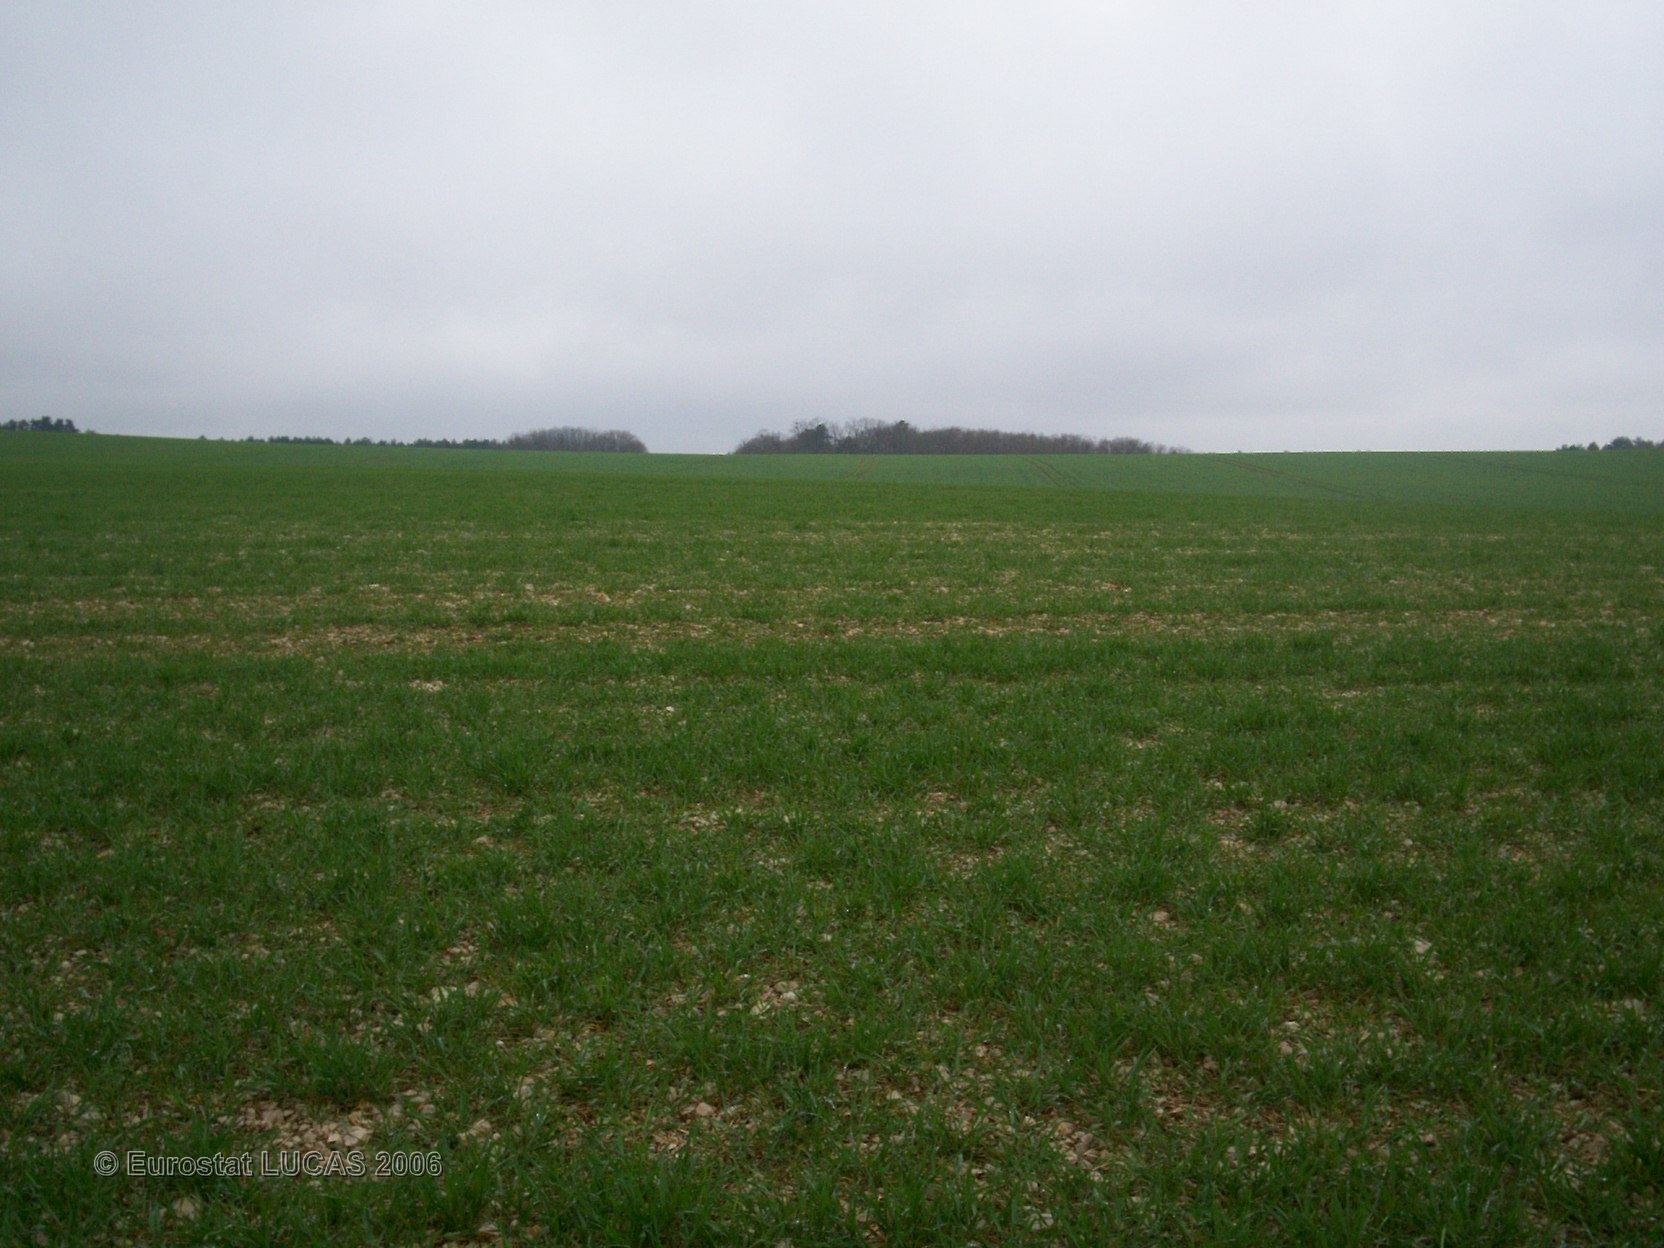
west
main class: Cropland
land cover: Common wheat
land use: Agriculture (excluding fallow land and kitchen gardens)
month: April
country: FR
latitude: 48.1032
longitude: 4.4784
